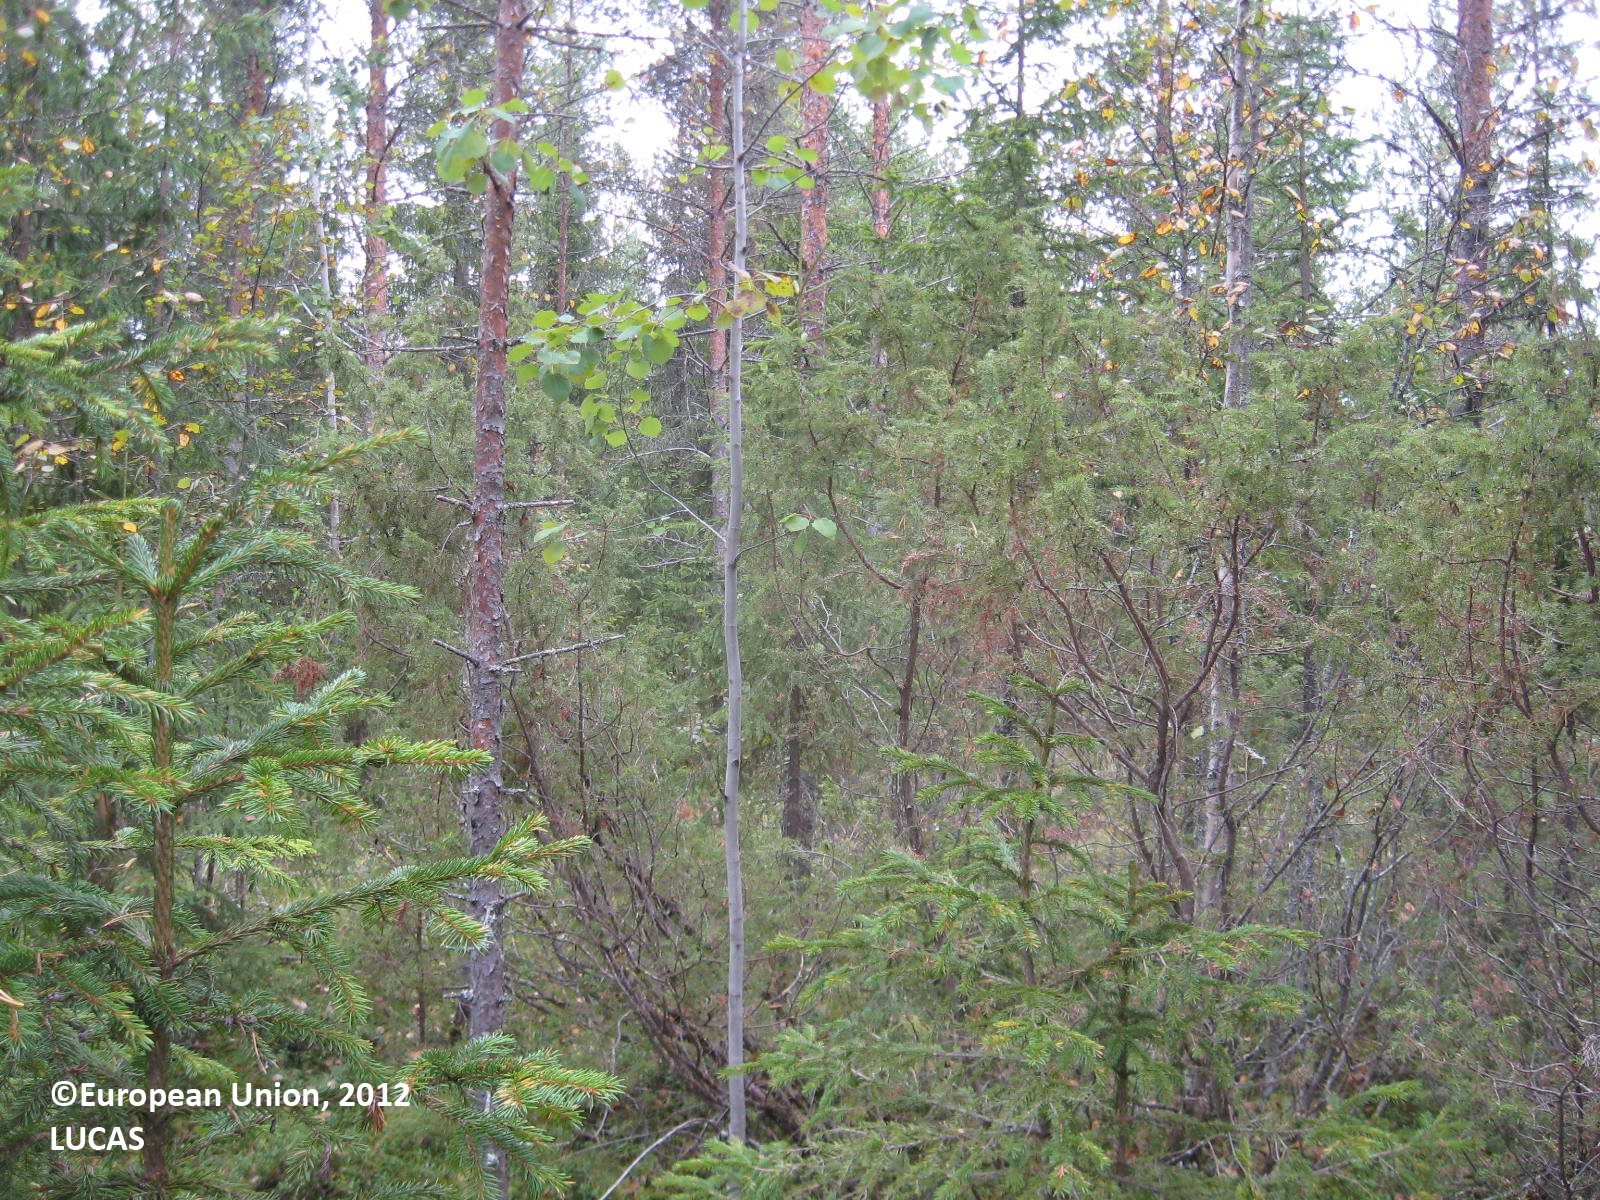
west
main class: Woodland
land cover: Pine dominated coniferous woodland
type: boreal forest
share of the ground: > 75 %
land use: Forestry
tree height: > 5 m
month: September
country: FI
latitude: 64.0196
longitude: 28.3670
